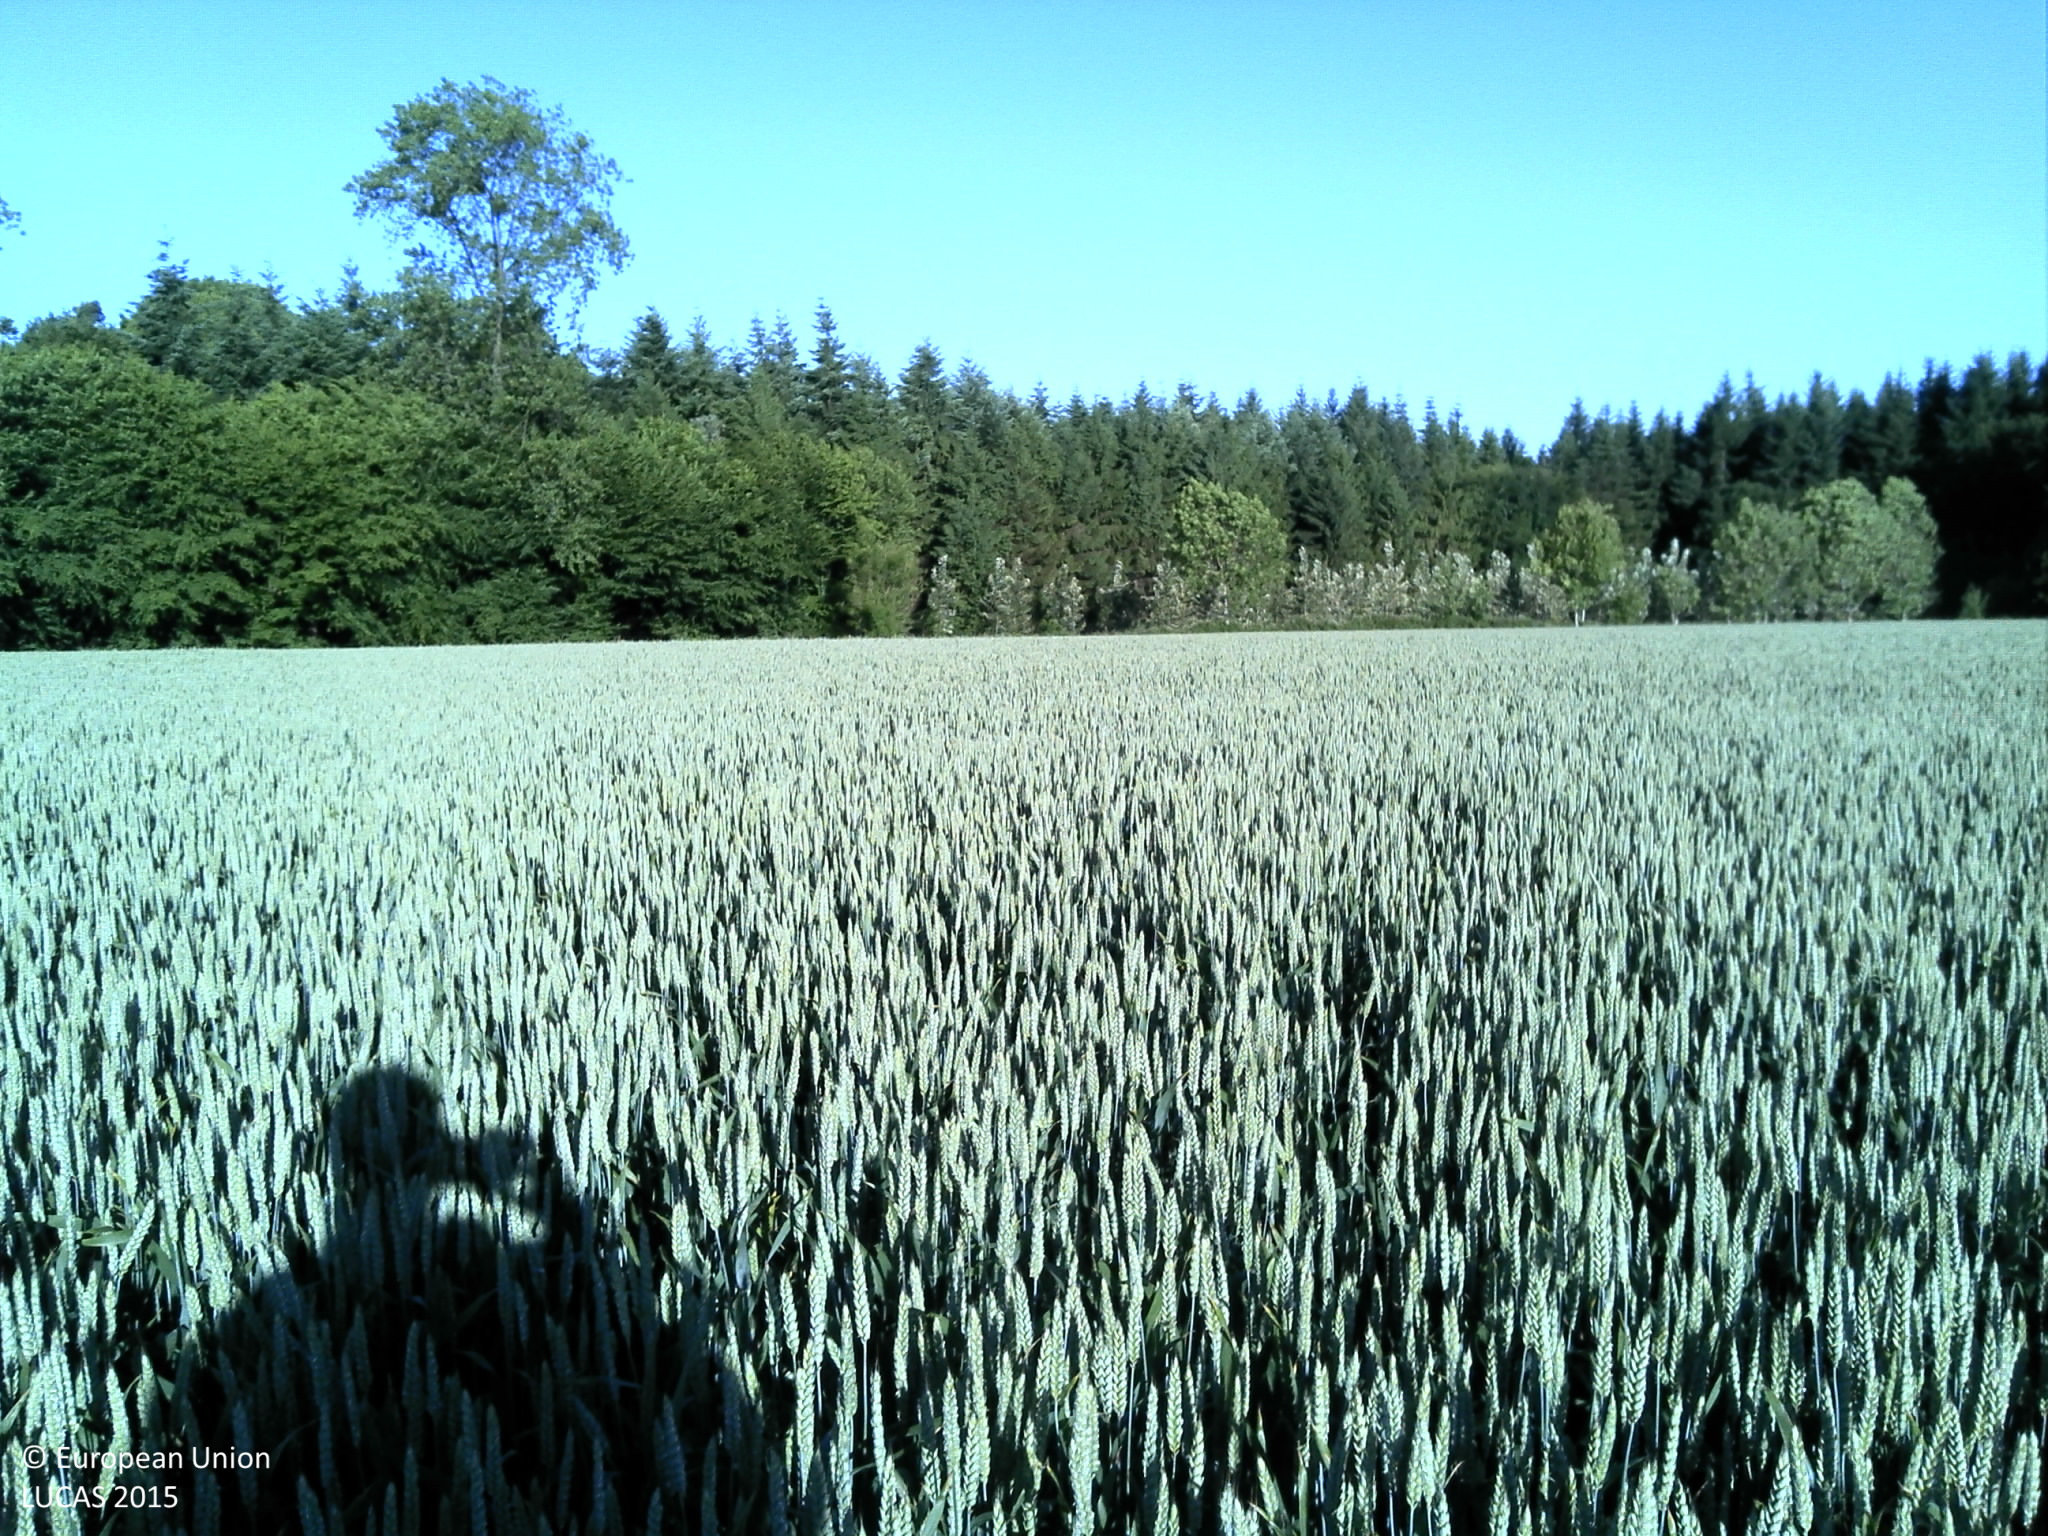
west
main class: Cropland
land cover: Common wheat
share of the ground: > 75 %
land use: Agriculture (excluding fallow land and kitchen gardens)
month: June
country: FR
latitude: 49.6102
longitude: 0.9959
